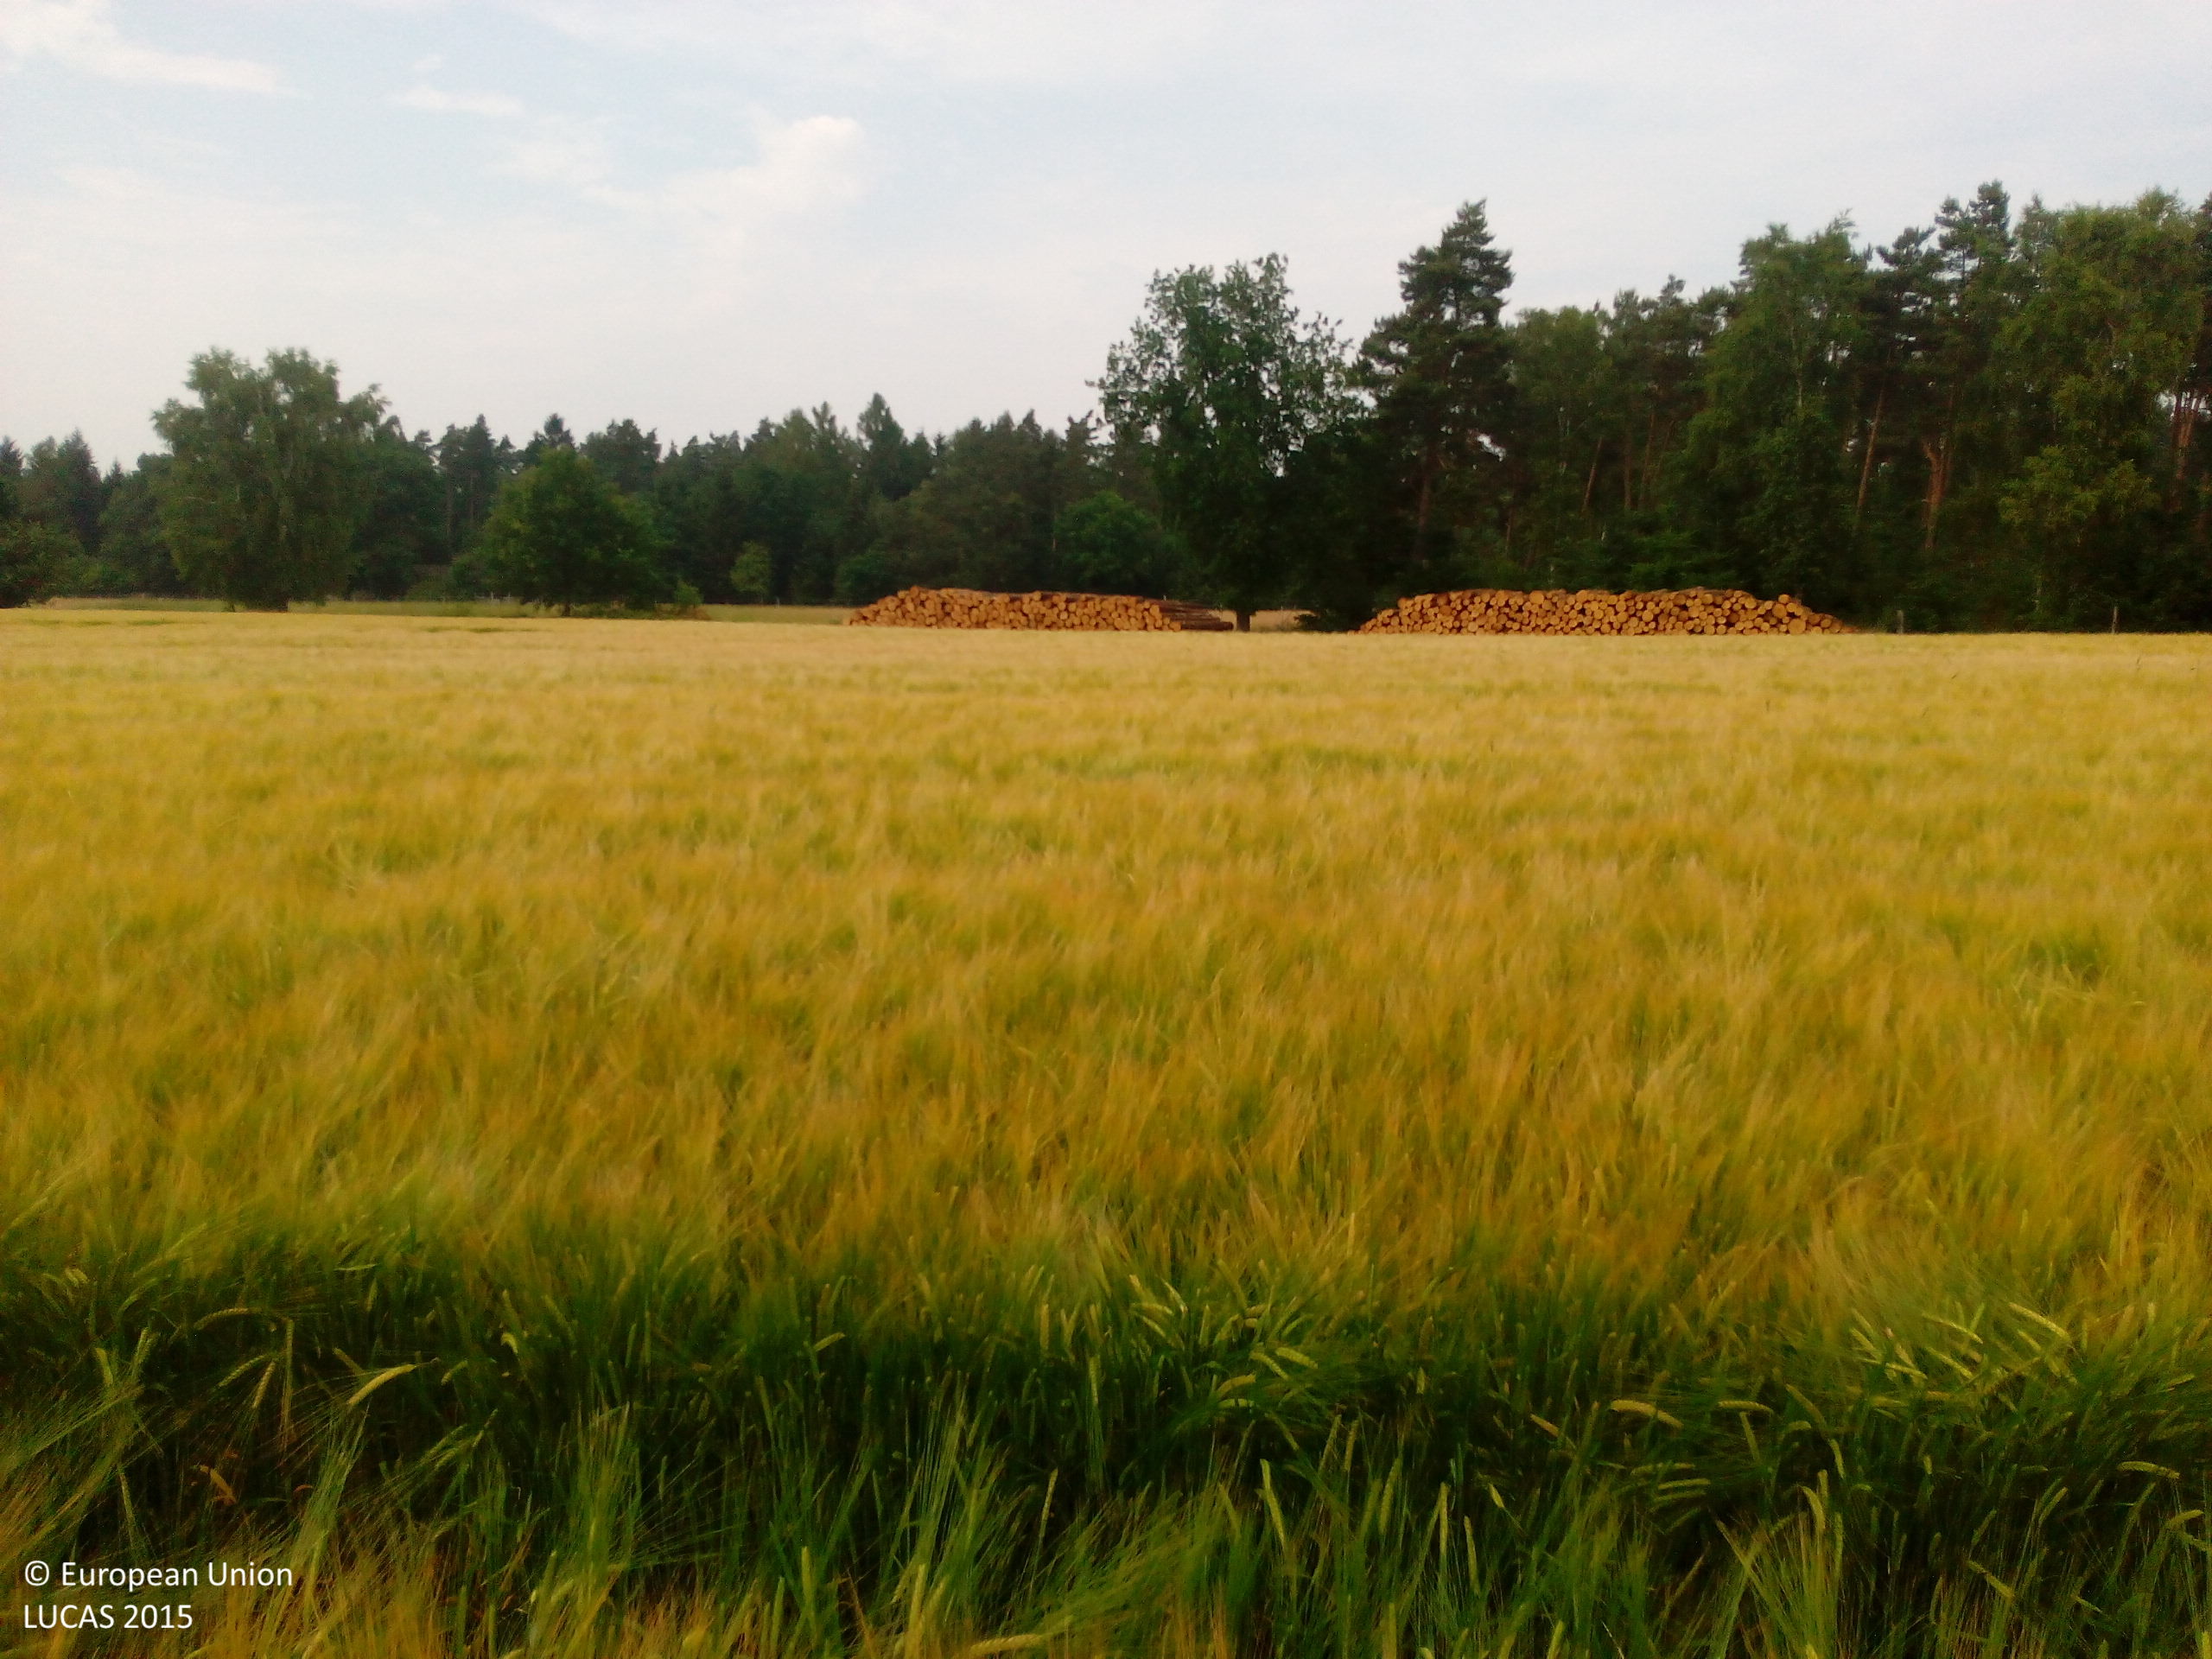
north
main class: Cropland
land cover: Barley
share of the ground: > 75 %
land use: Agriculture (excluding fallow land and kitchen gardens)
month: July
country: DE
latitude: 52.6271
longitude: 10.6941
